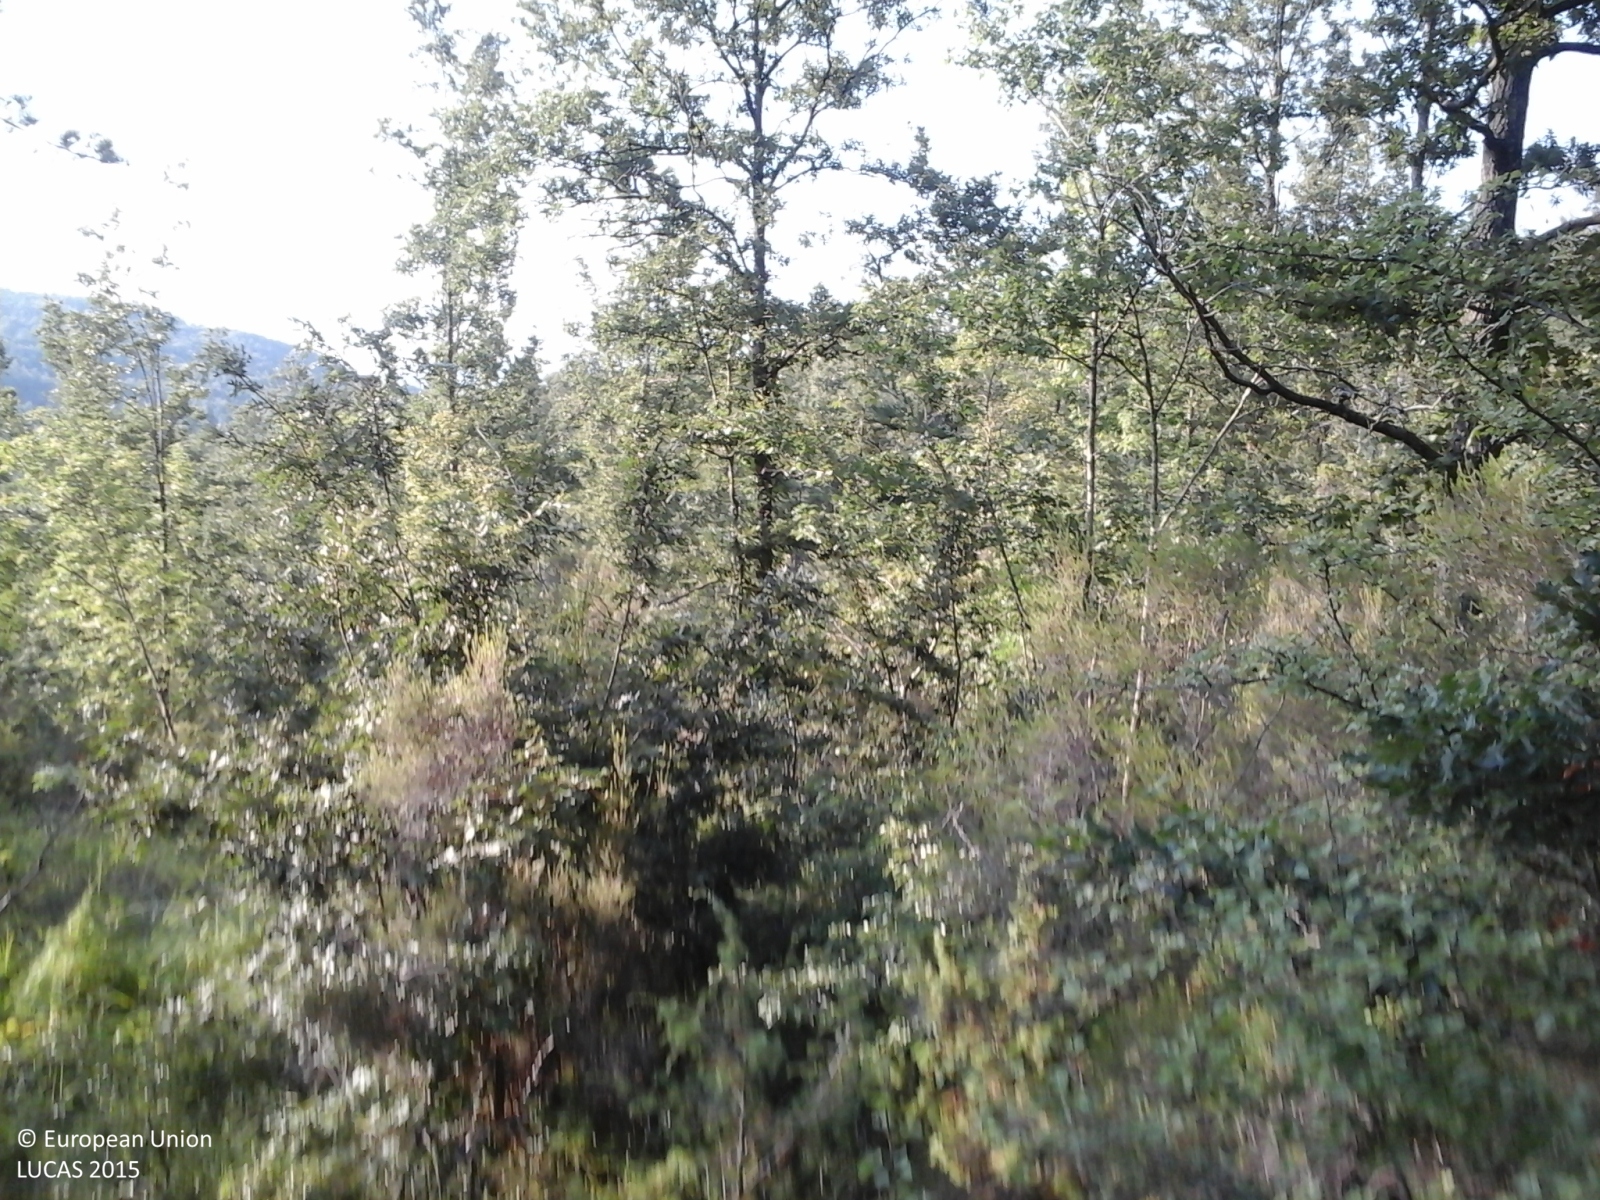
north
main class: Woodland
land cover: Pine dominated mixed woodland
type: coniferous forest of the mediterranean region
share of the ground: > 75 %
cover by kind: coniferous forest trees 45 %, broadleaved forest trees 25 %, shrubs 20 %, herbaceous plants 10 %
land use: Forestry
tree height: > 5 m
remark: Clear cut
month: August
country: IT
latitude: 42.7856
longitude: 11.6206
